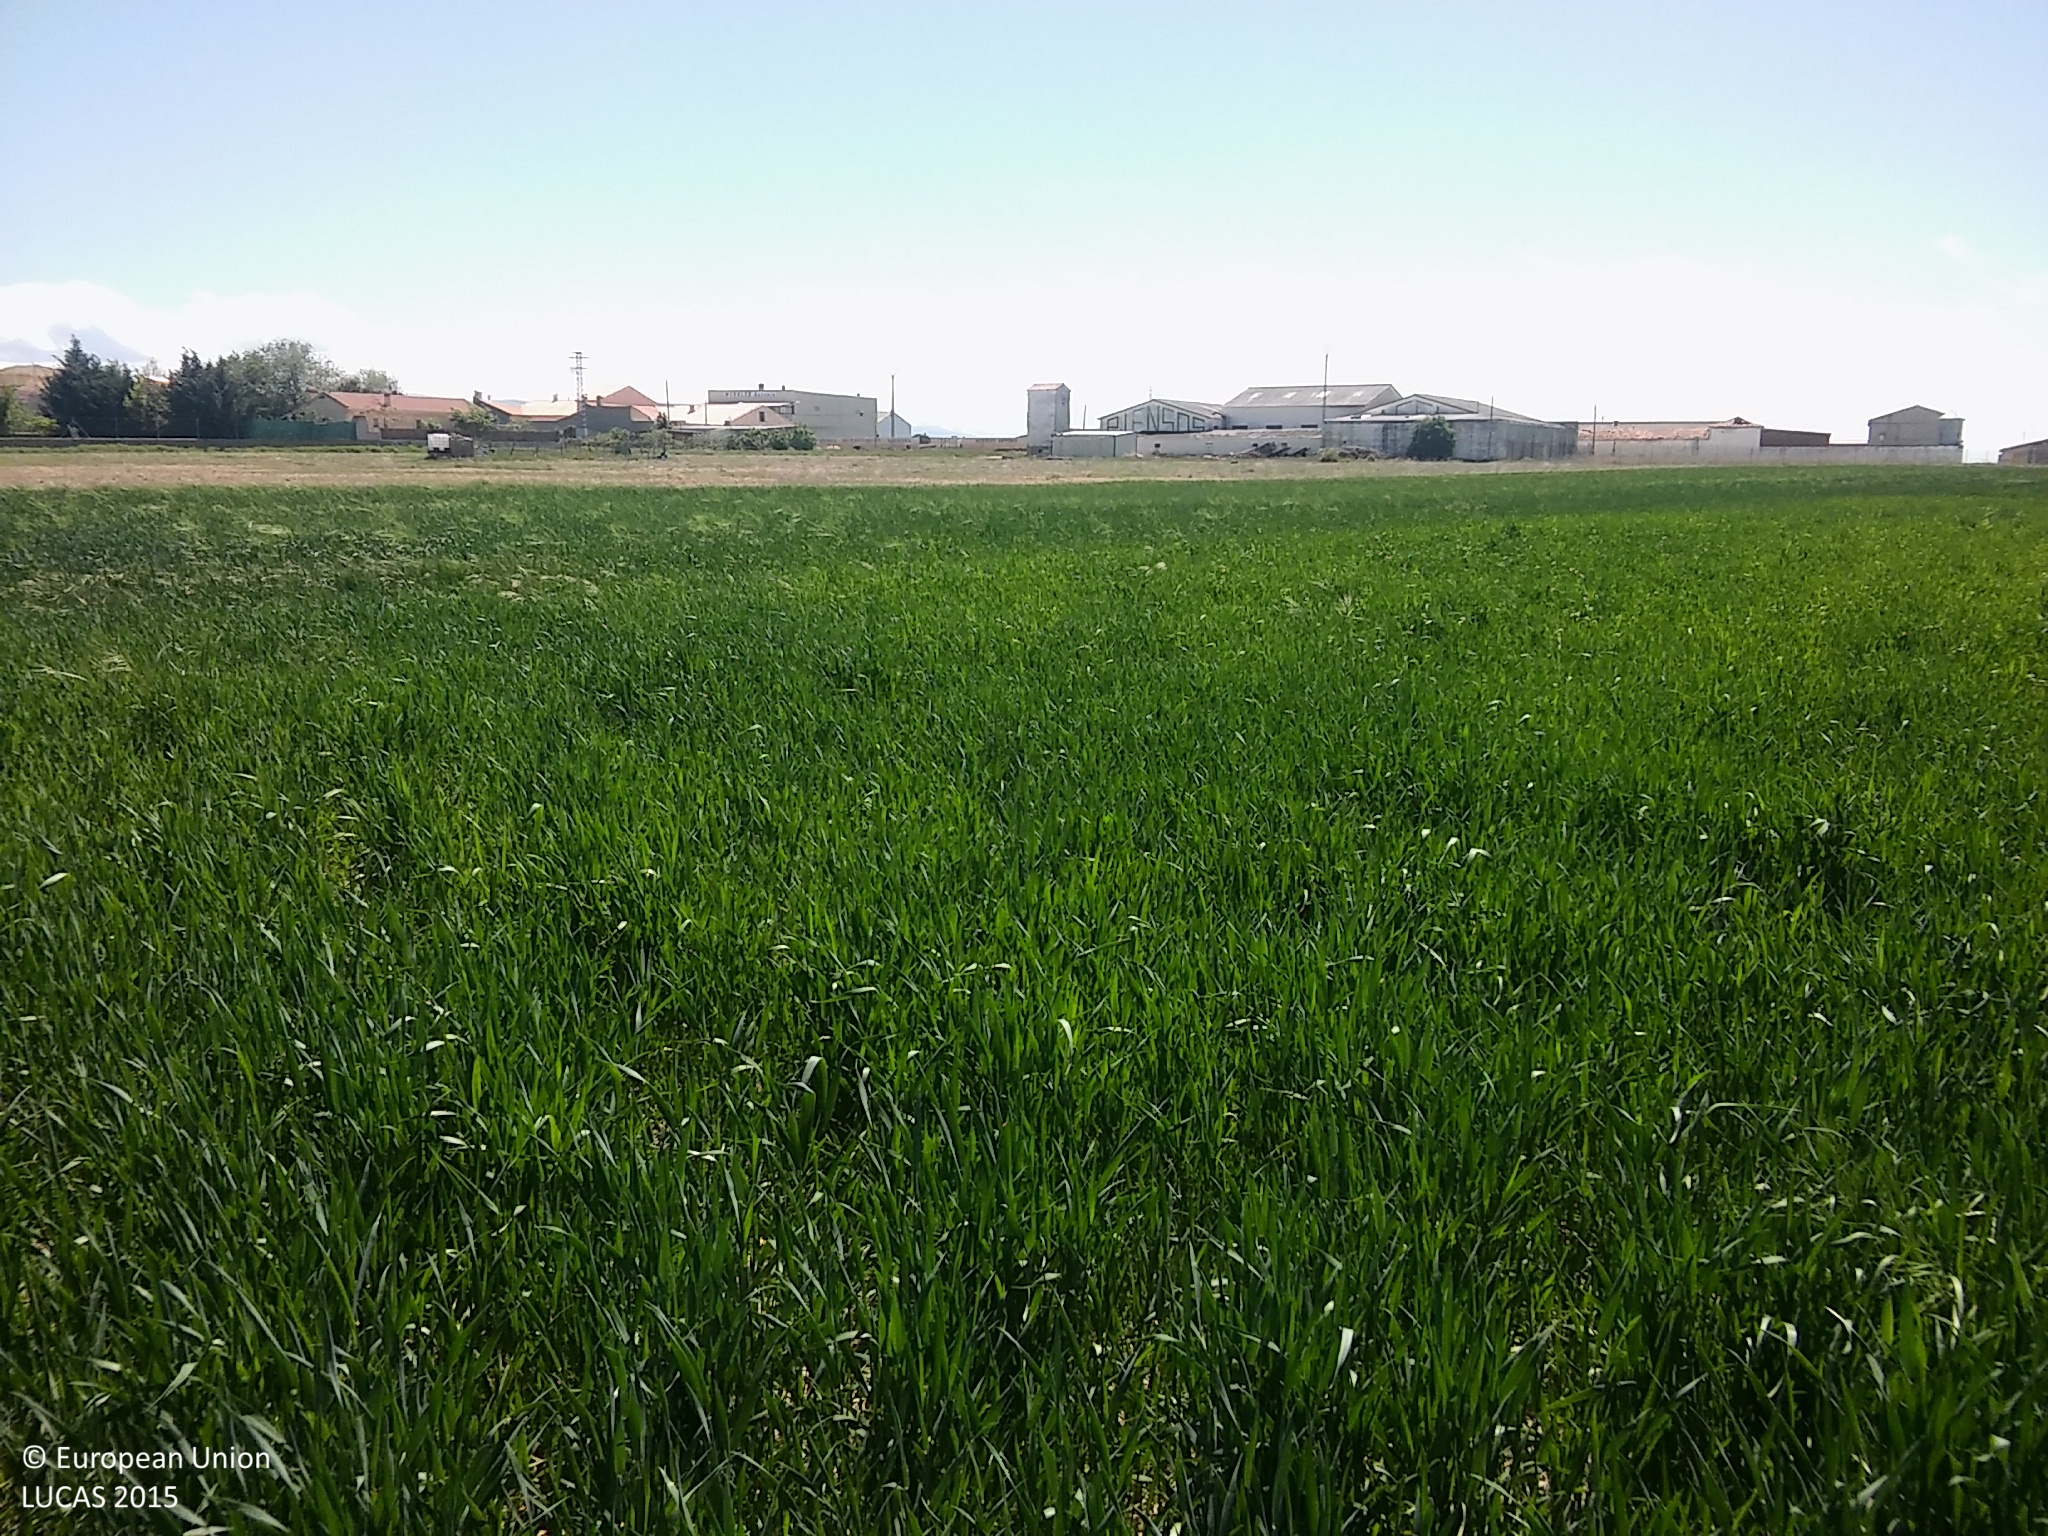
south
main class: Cropland
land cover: Common wheat
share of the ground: > 75 %
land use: Agriculture (excluding fallow land and kitchen gardens)
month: May
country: ES
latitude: 41.2646
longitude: -3.9335
